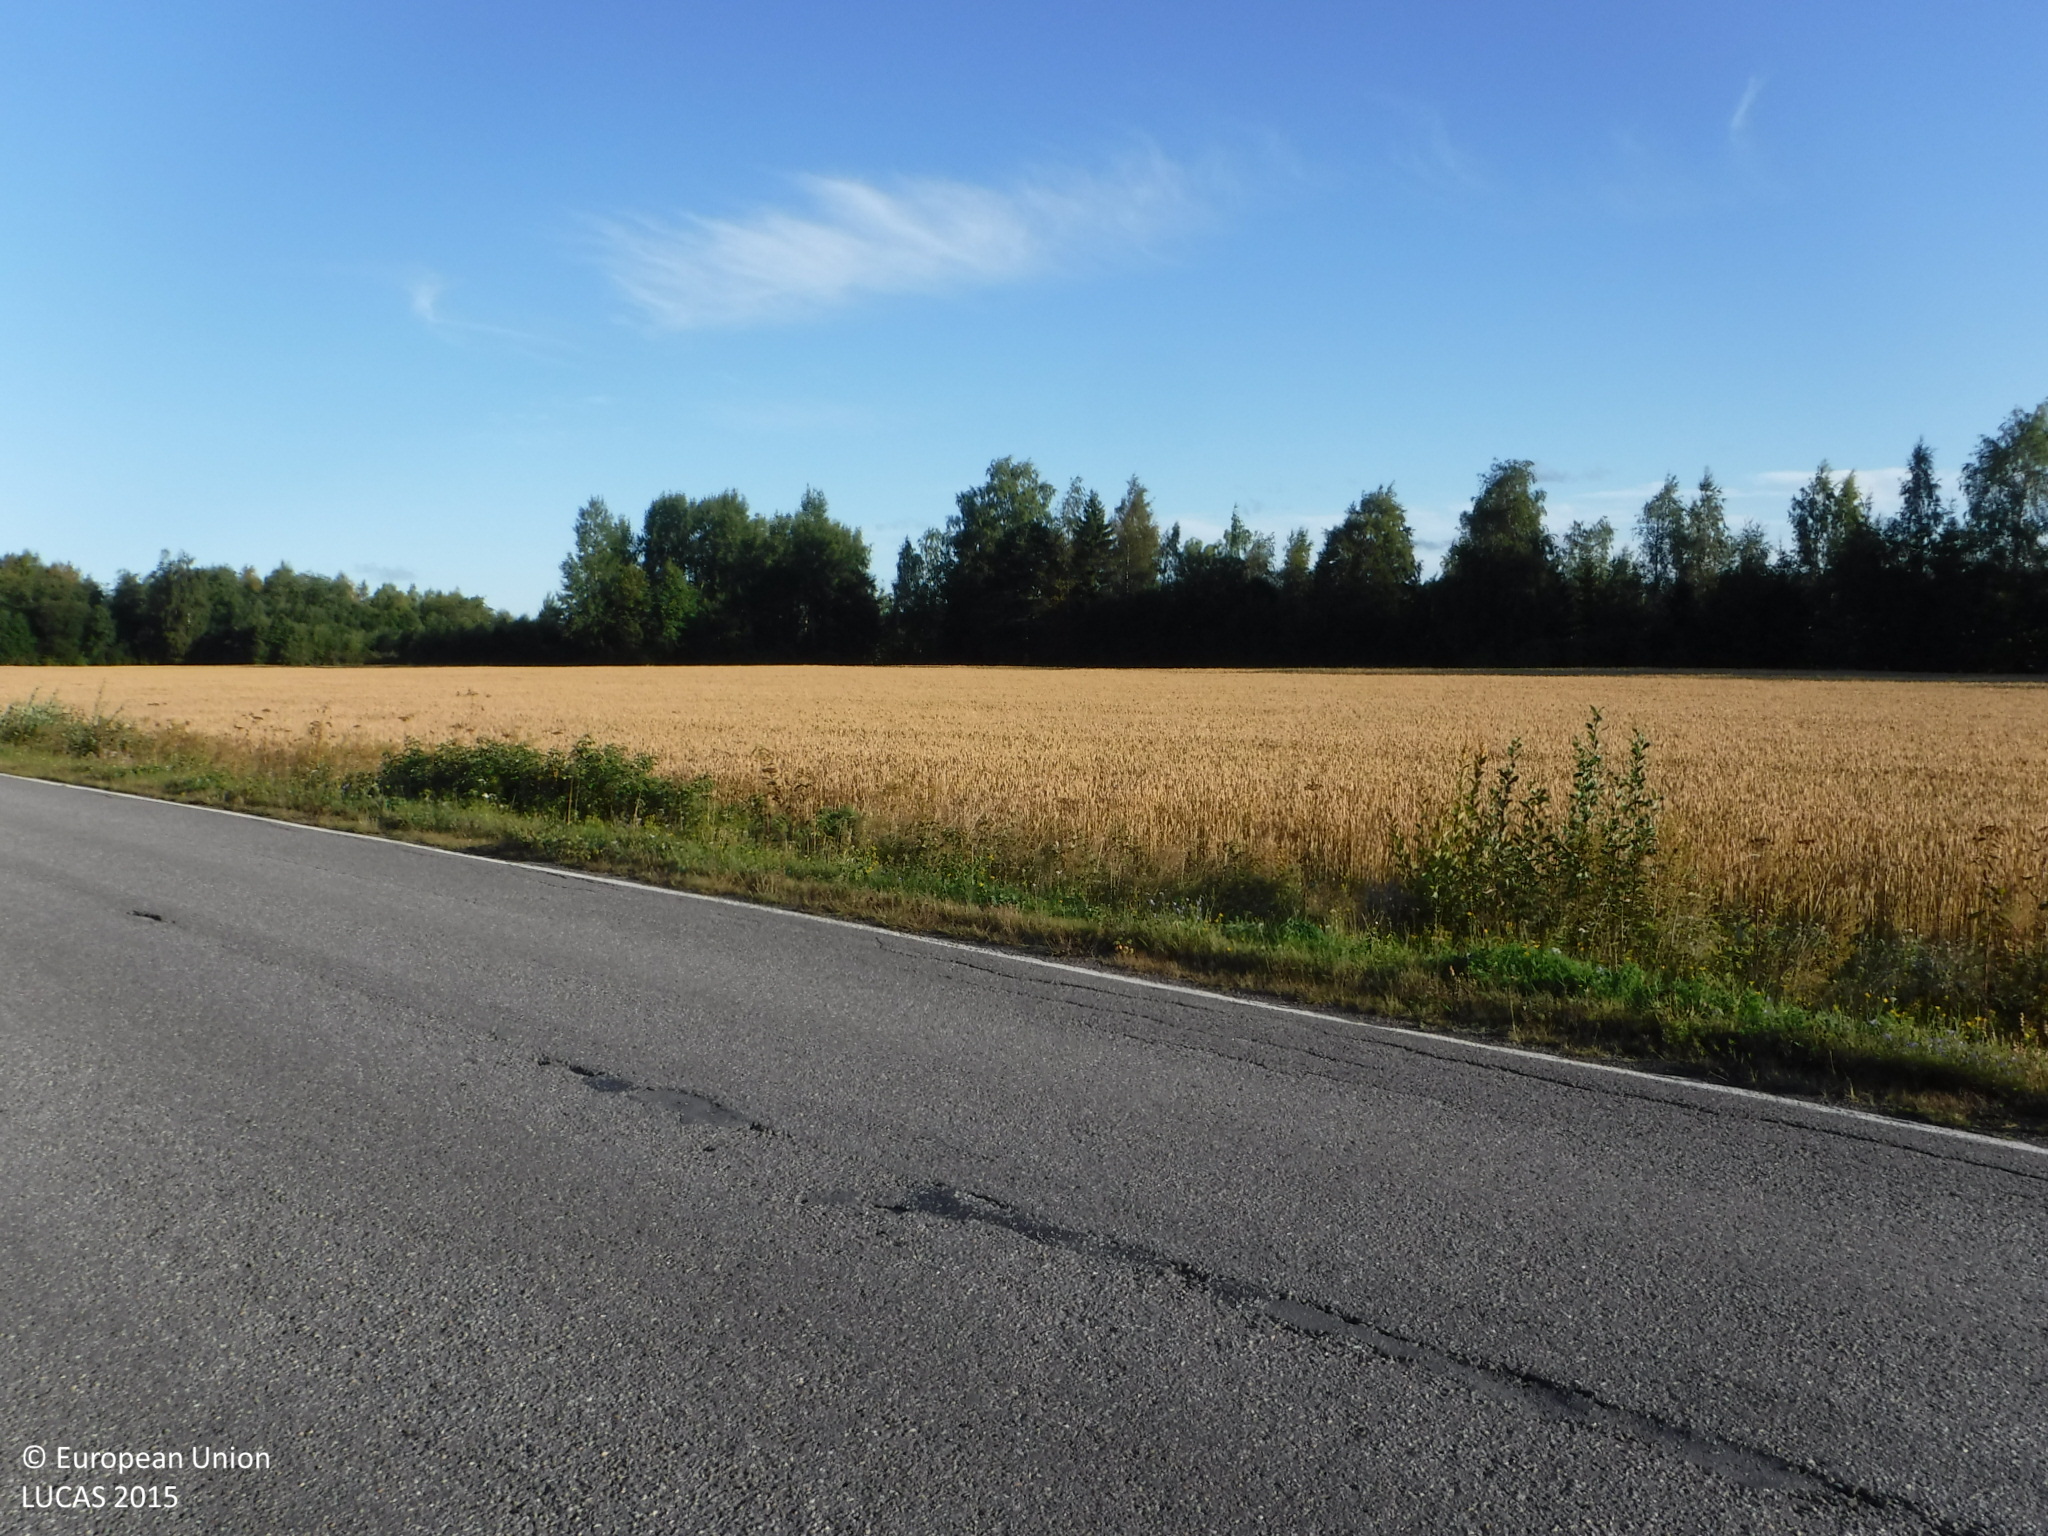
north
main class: Cropland
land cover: Barley
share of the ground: > 75 %
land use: Agriculture (excluding fallow land and kitchen gardens)
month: August
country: FI
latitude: 61.2910
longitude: 22.2096
